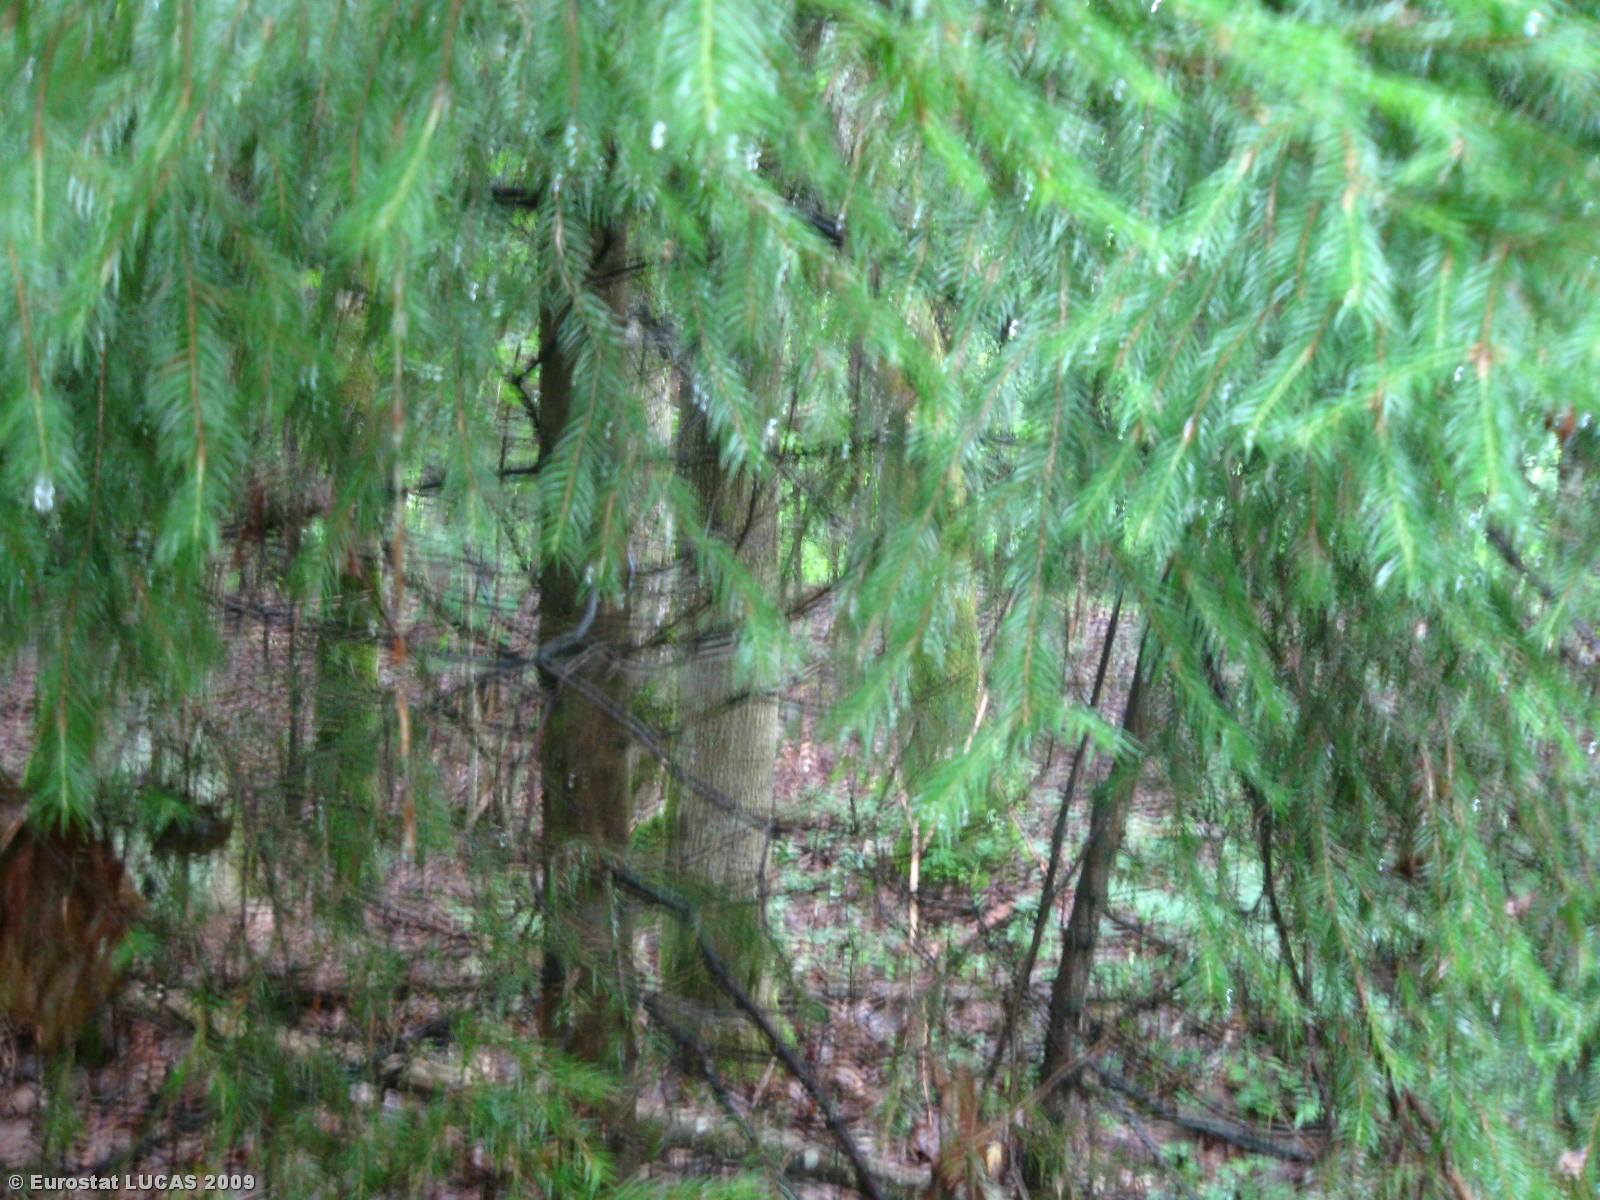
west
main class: Woodland
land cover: Mixed woodland
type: hemiboreal forest and nemoral coniferous forest and mixed broadleaved-coniferous forest
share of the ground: > 75 %
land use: Forestry
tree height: > 5 m
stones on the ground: < 10 %
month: July
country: LT
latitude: 55.1525
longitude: 24.8446
